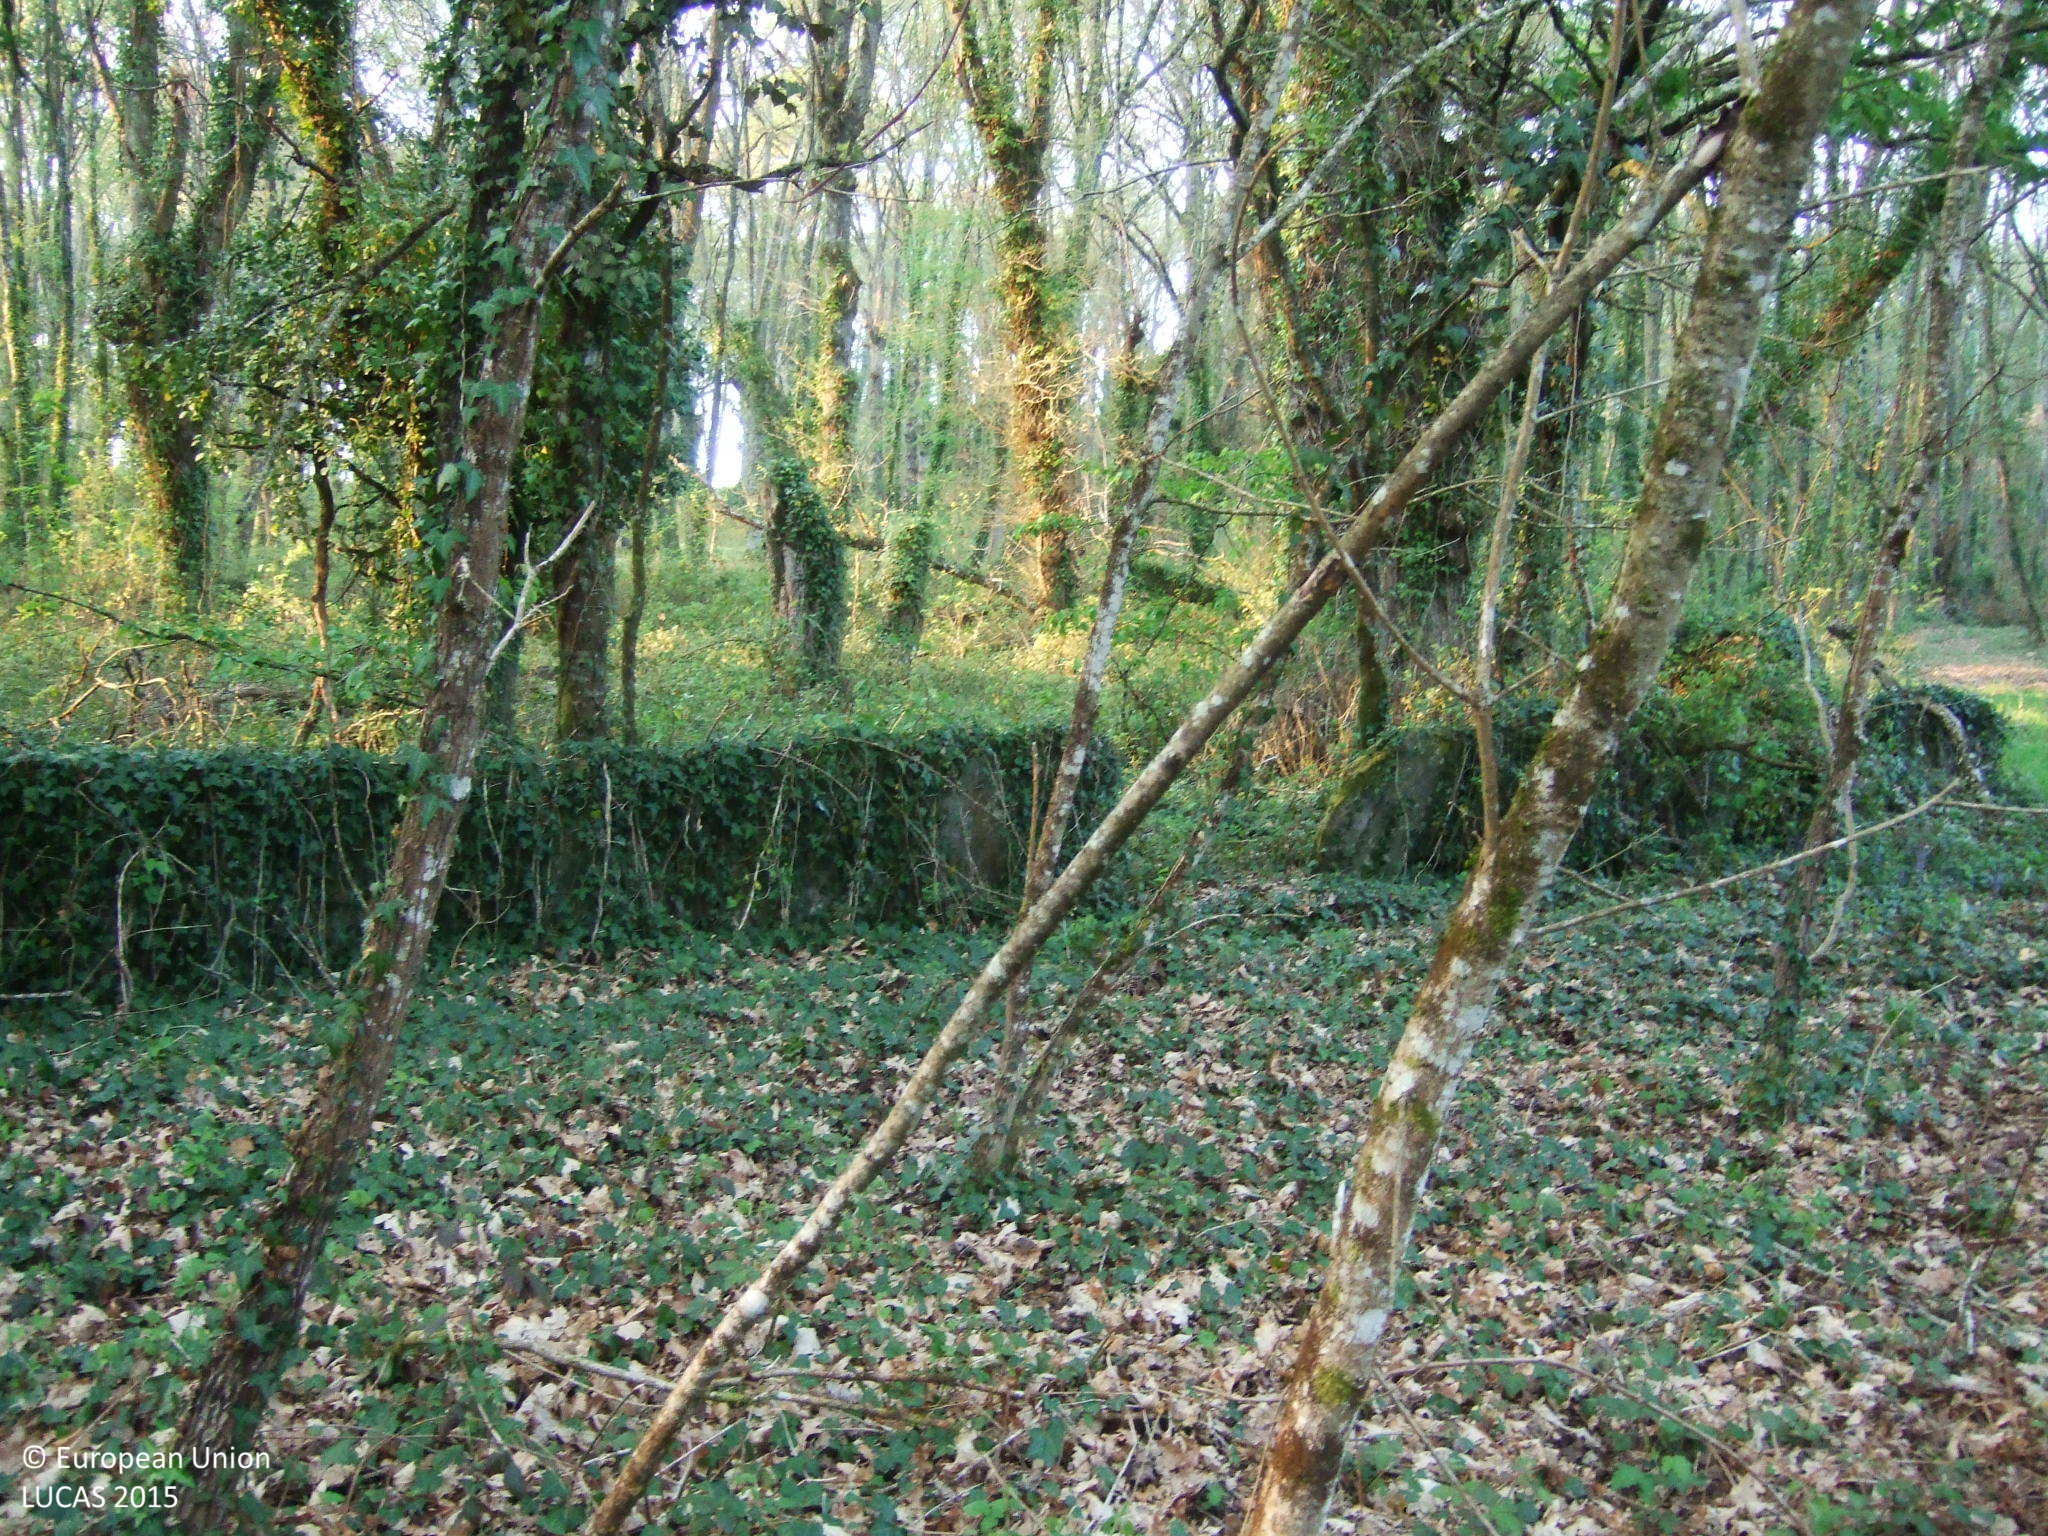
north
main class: Woodland
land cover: Broadleaved woodland
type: acidophilous oak and oak-birch forest
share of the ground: > 75 %
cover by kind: broadleaved forest trees 90 %, shrubs 10 %
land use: Forestry
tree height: > 5 m
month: April
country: ES
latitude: 43.0181
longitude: -7.5879
